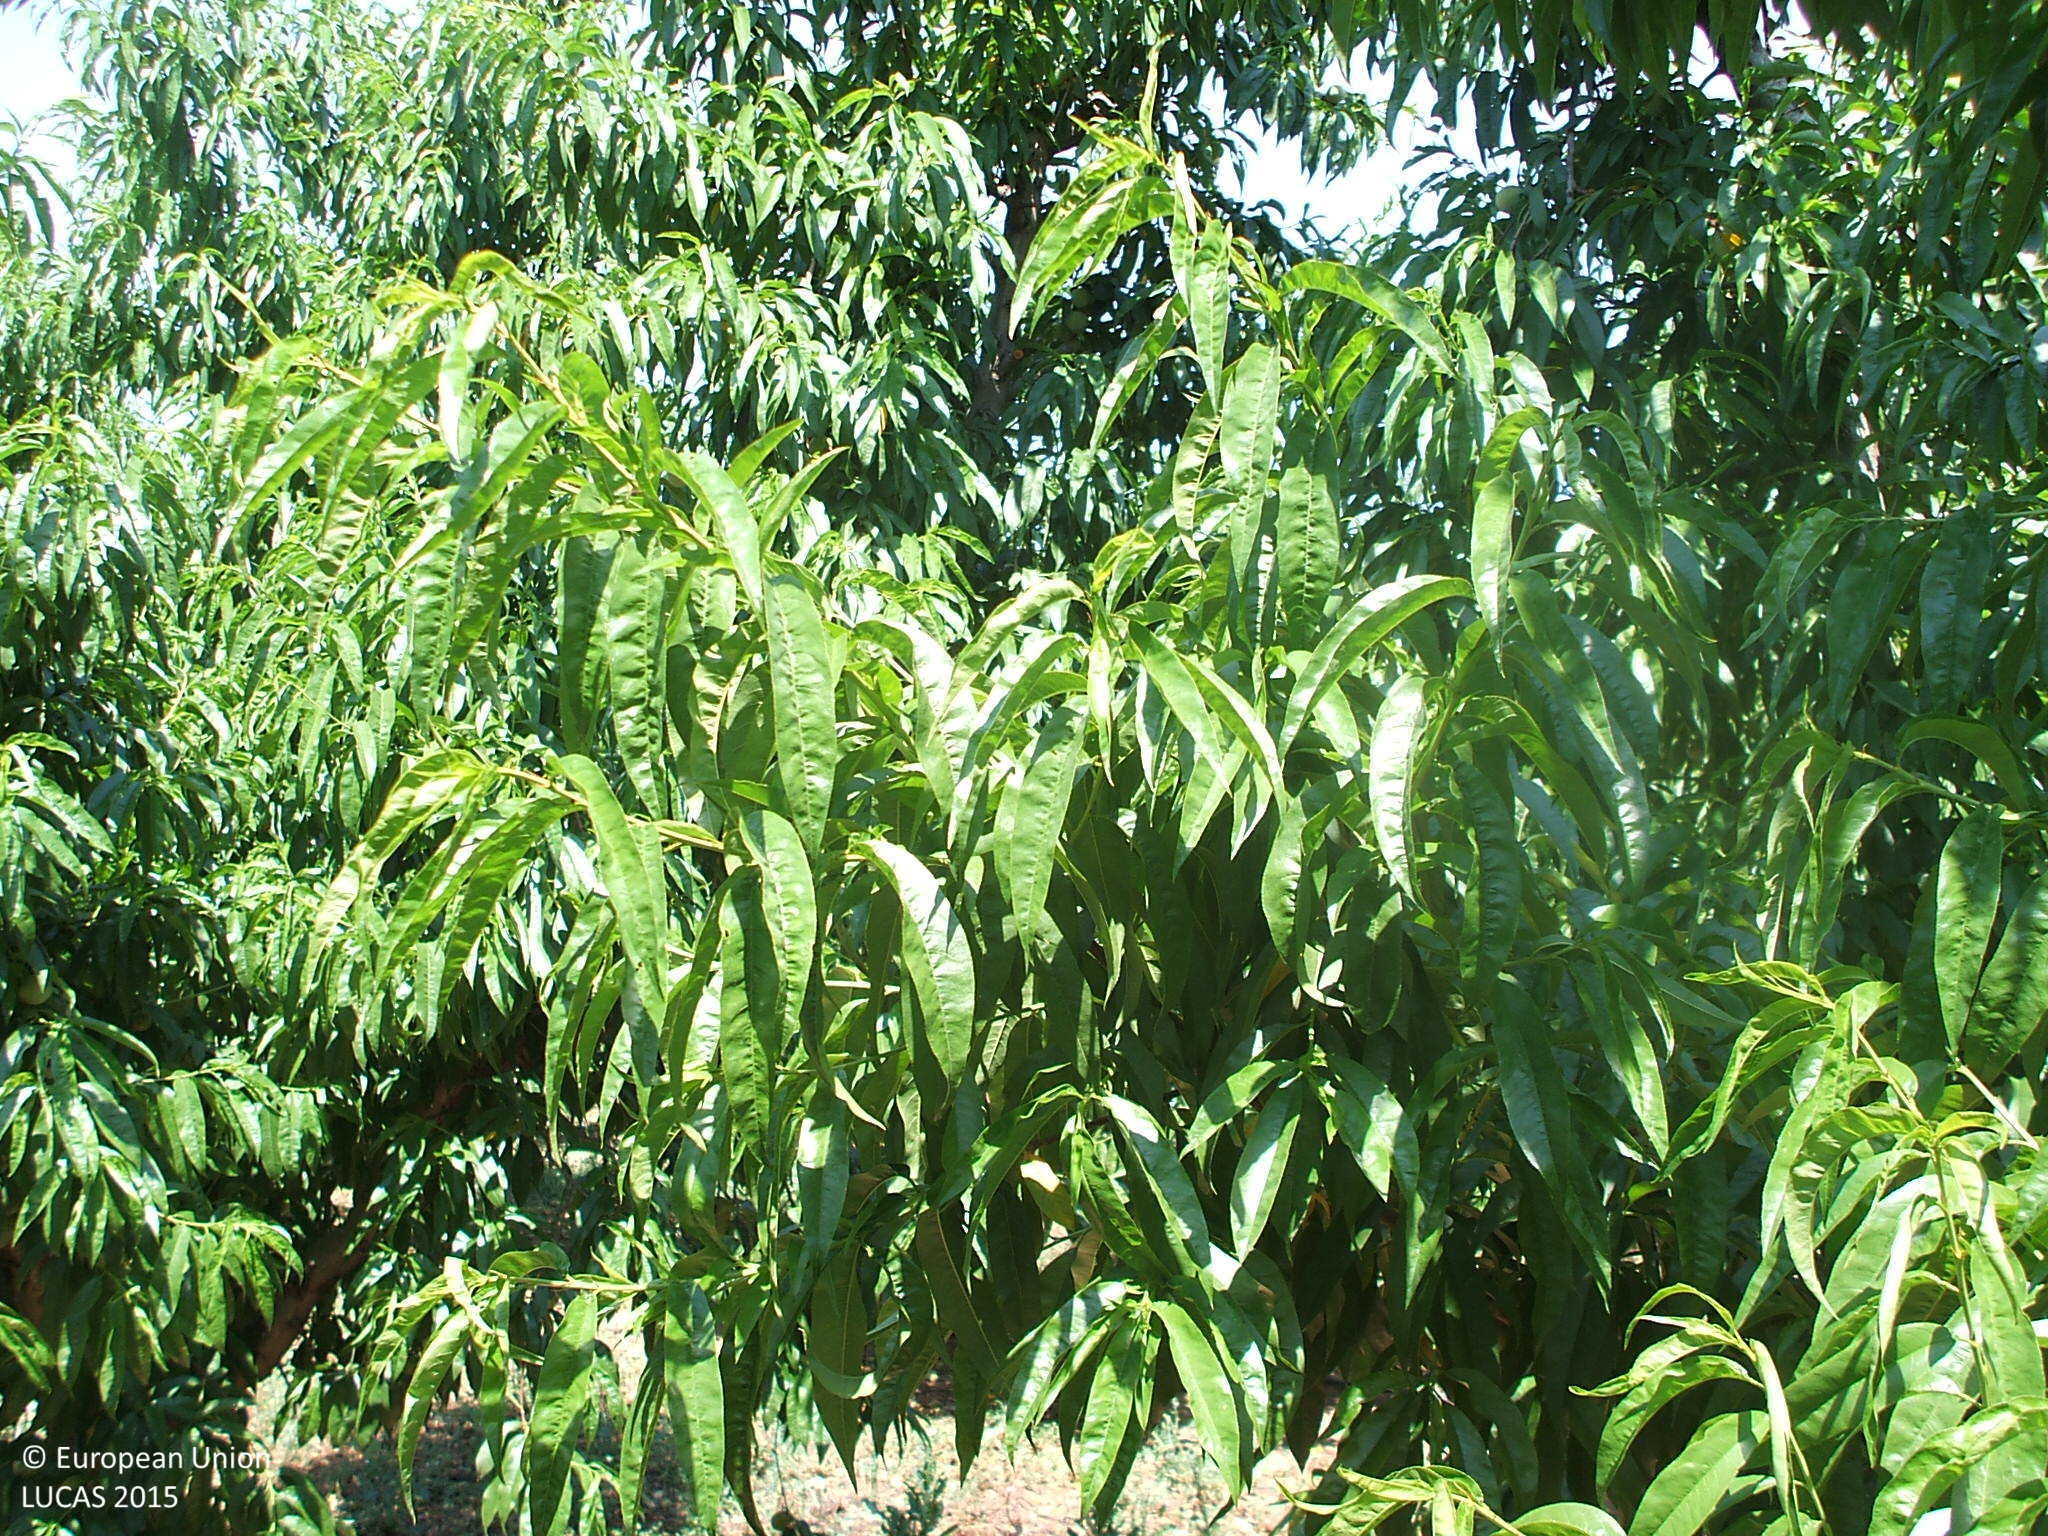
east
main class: Cropland
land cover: Other fruit trees and berries
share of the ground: > 75 %
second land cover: Grassland without tree/shrub cover
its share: > 75 %
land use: Agriculture (excluding fallow land and kitchen gardens)
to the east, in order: Other fruit trees and berries; Grassland without tree/shrub cover; Shrubland without tree cover; Other fruit trees and berries; Shrubland without tree cover; Paved roads, cycling and walking lanes; Shruby margins; Other fruit trees and berries; Shrubland without tree cover; Rock outcrops; Shrubland without tree cover; Grassland without tree/shrub cover; Tracks; Shrubland without tree cover; Tracks; Grass margins; Inland fresh running water
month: June
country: ES
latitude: 40.9556
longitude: -0.1925
